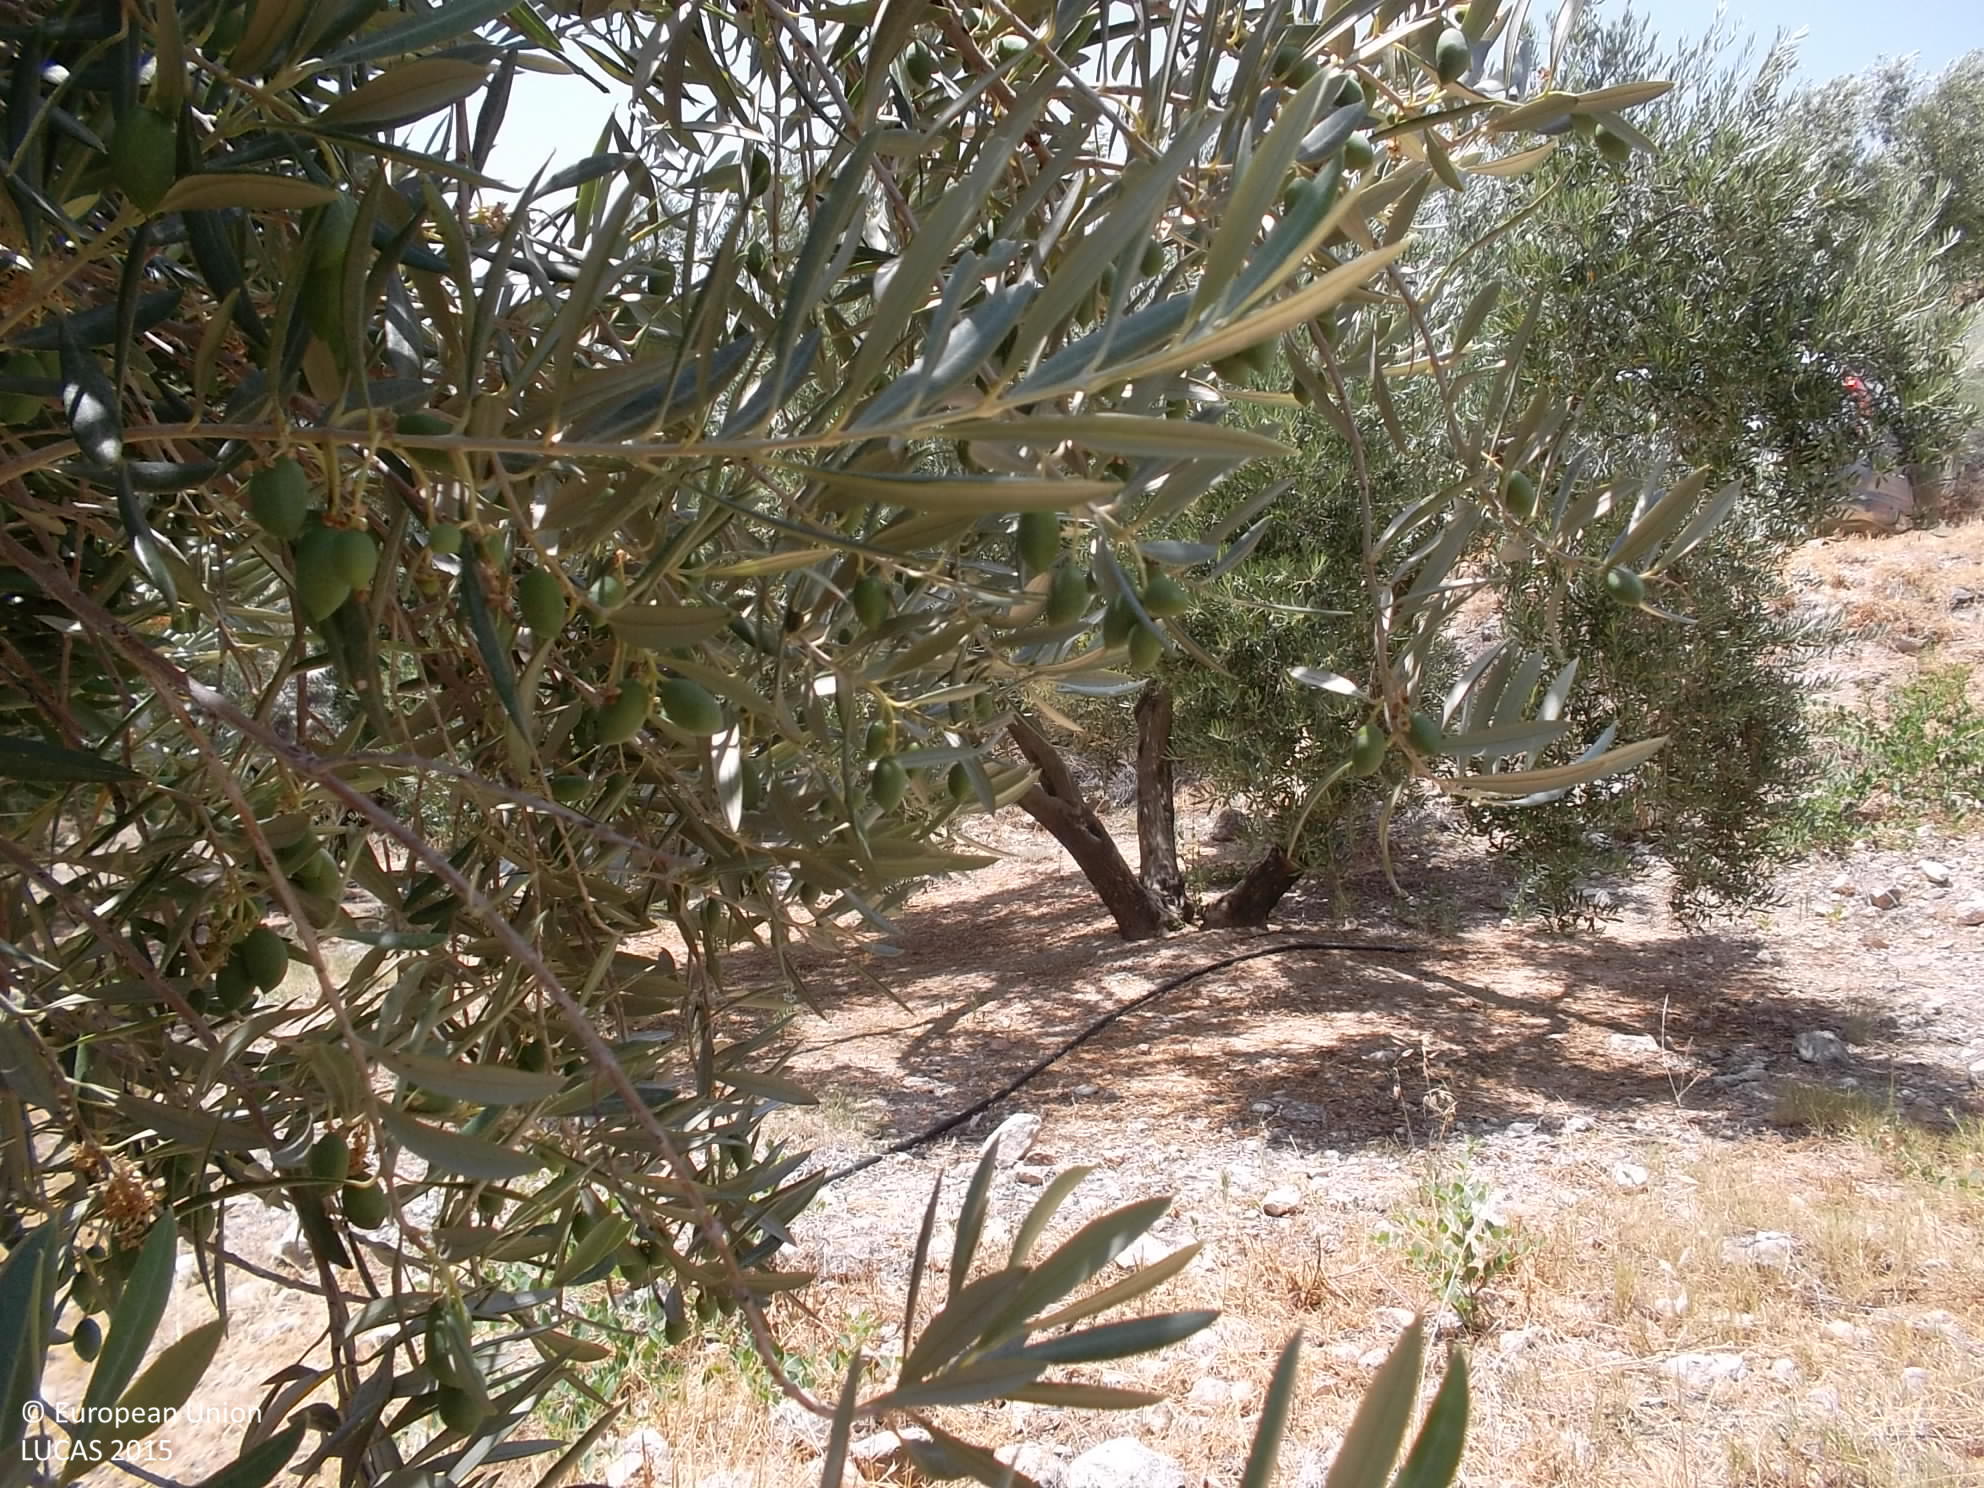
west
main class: Cropland
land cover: Olive groves
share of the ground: 25 - 50 %
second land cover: Spontaneously vegetated surfaces
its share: > 75 %
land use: Agriculture (excluding fallow land and kitchen gardens)
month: June
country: ES
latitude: 37.7452
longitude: -3.0327
